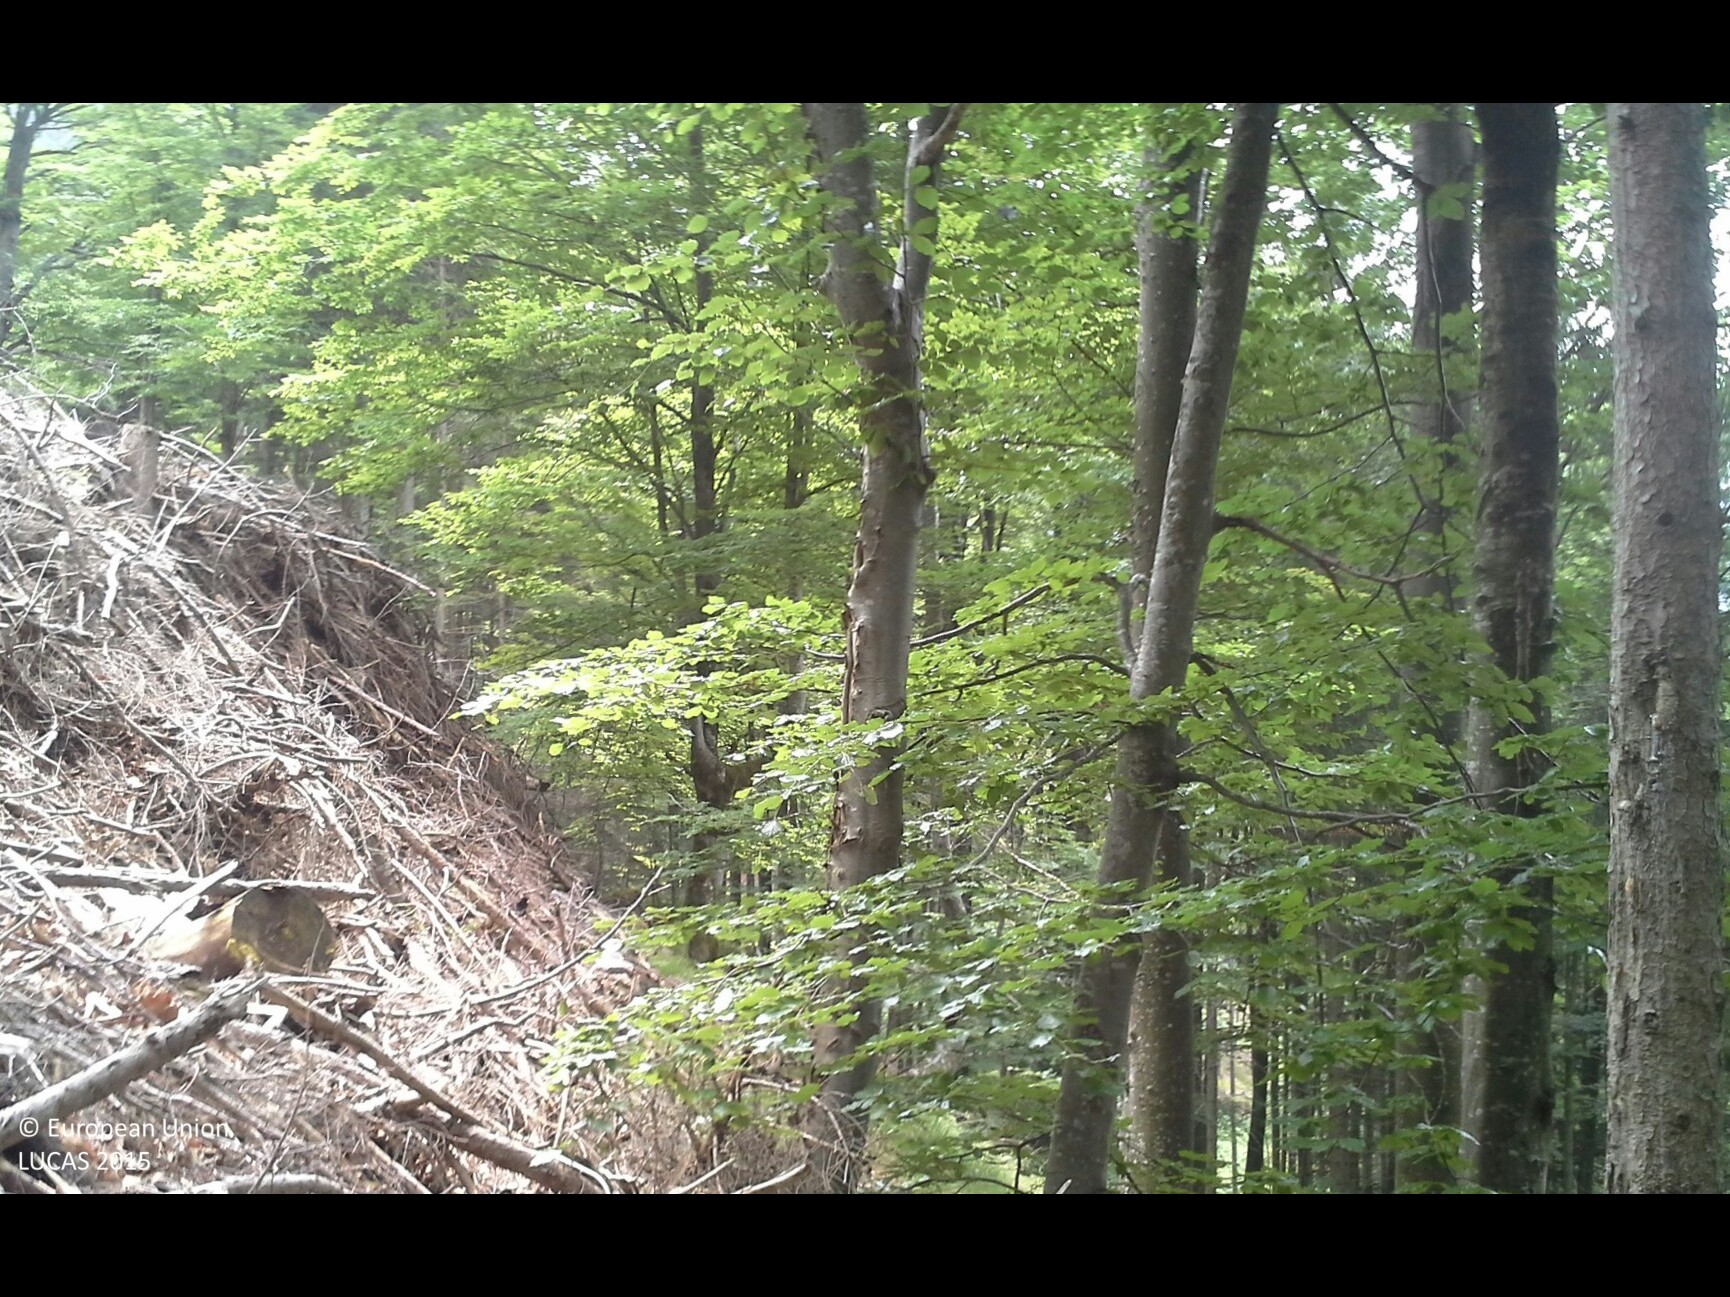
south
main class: Woodland
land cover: Spruce dominated mixed woodland
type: beech forest
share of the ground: > 75 %
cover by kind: broadleaved forest trees 60 %, coniferous forest trees 25 %, herbaceous plants 10 %, unconsolidated bare surface 5 %
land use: Forestry
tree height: > 5 m
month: June
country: AT
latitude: 47.7626
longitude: 13.7746
